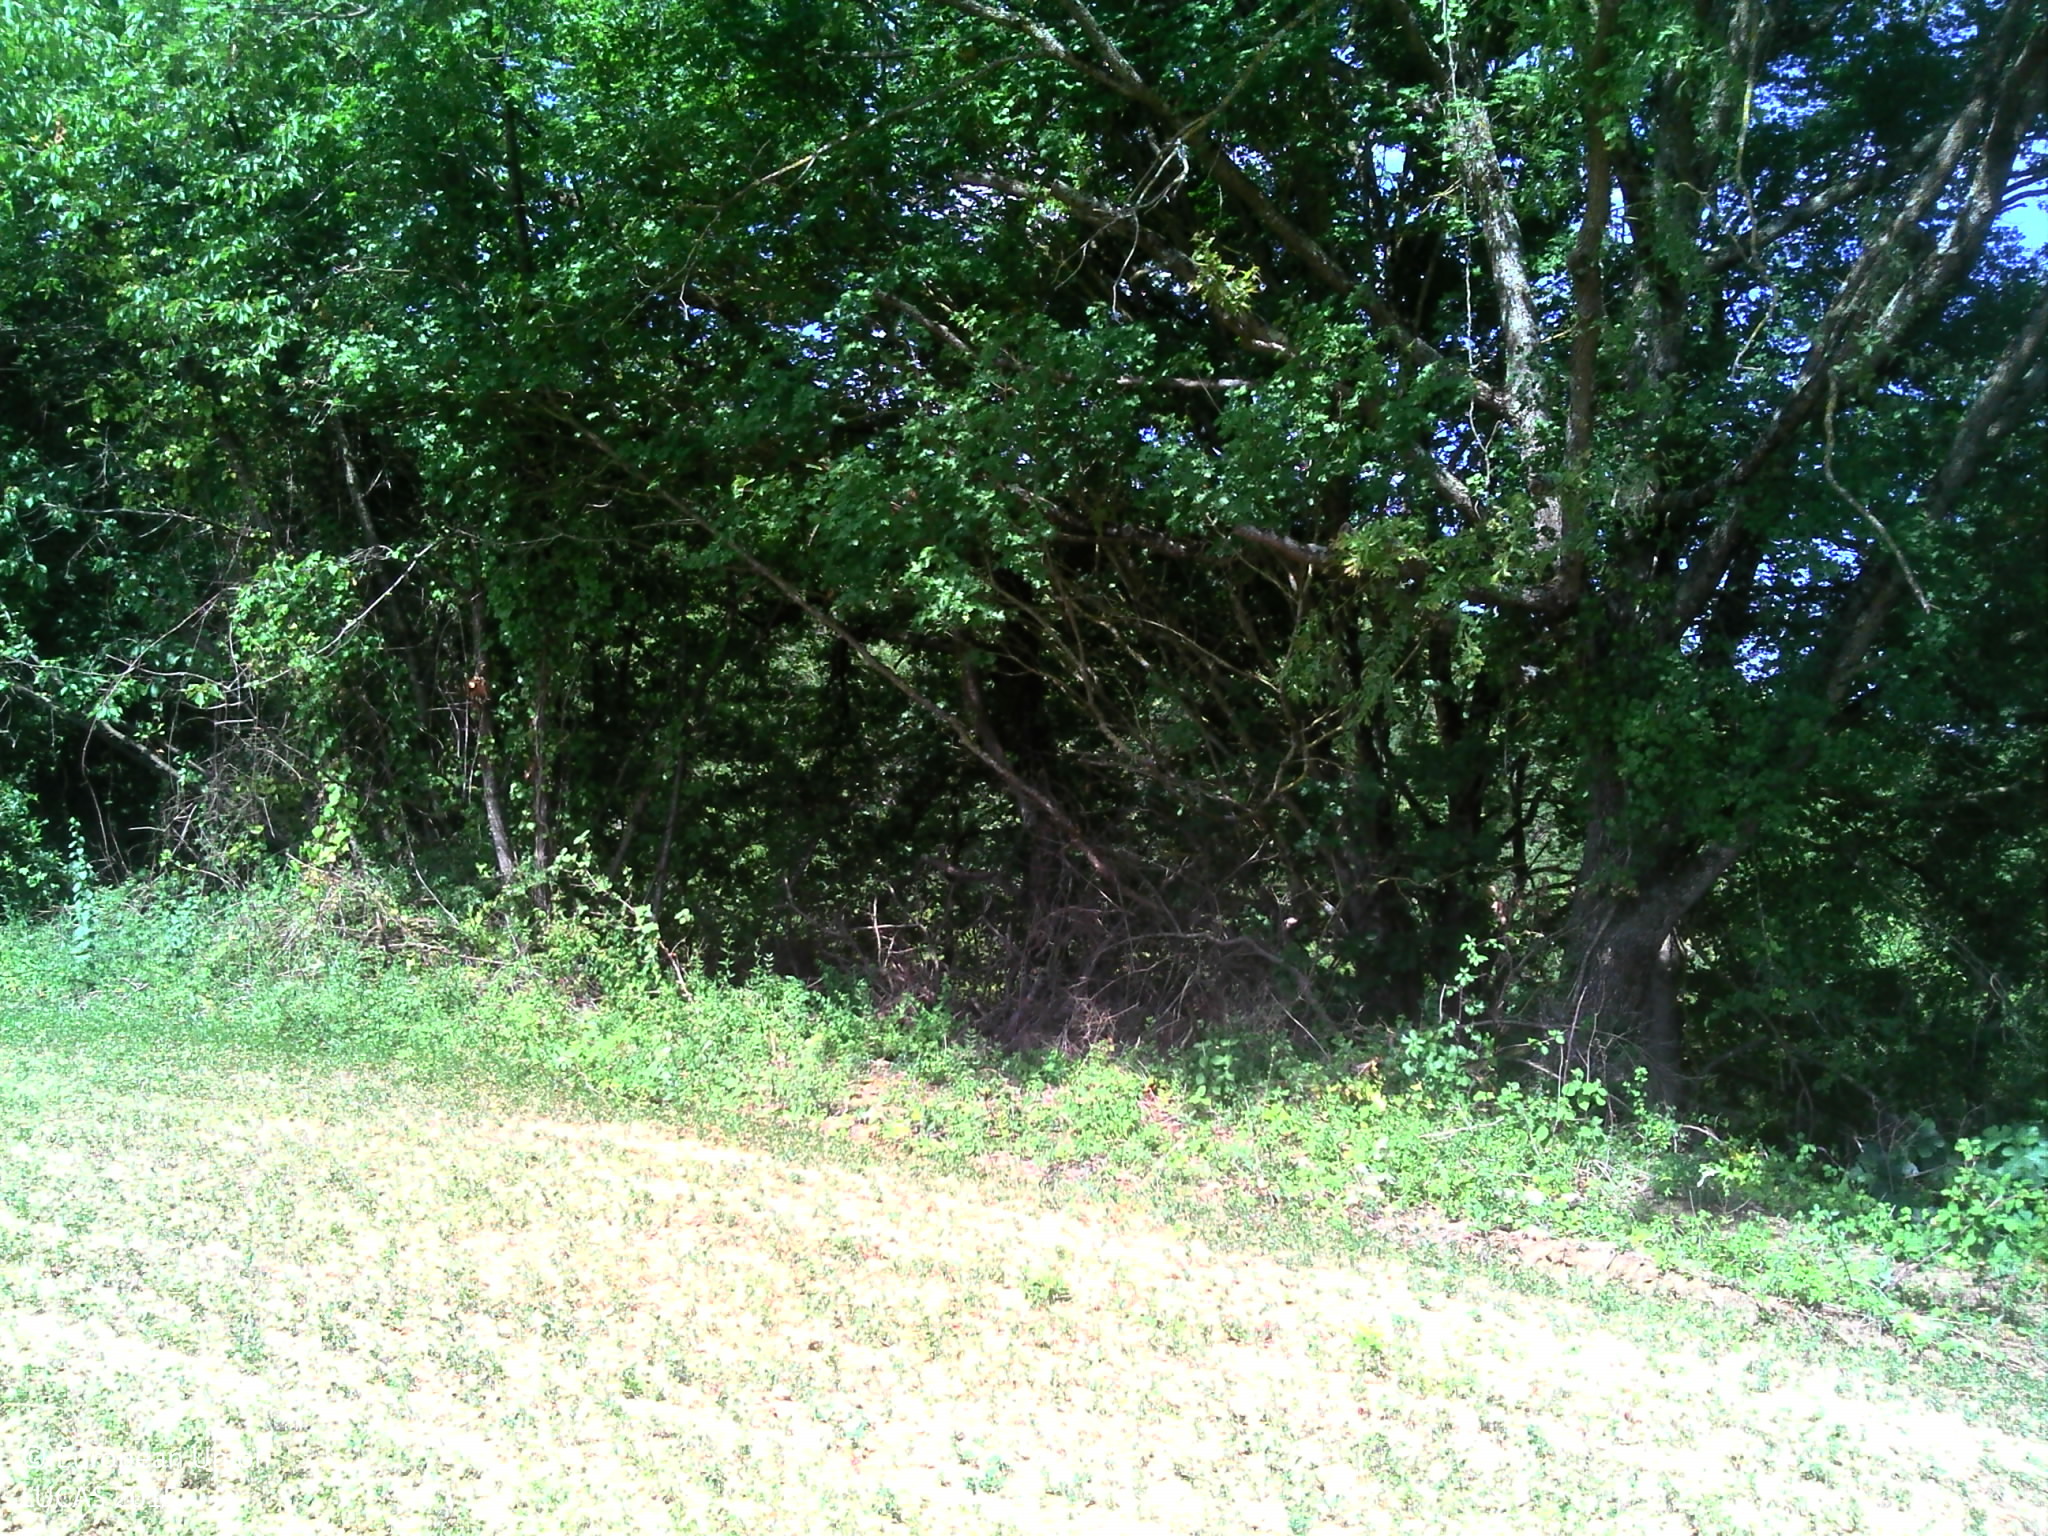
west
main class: Cropland
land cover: Lucerne
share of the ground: > 75 %
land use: Agriculture (excluding fallow land and kitchen gardens)
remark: Harvested field
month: July
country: FR
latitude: 43.1816
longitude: 1.0341
